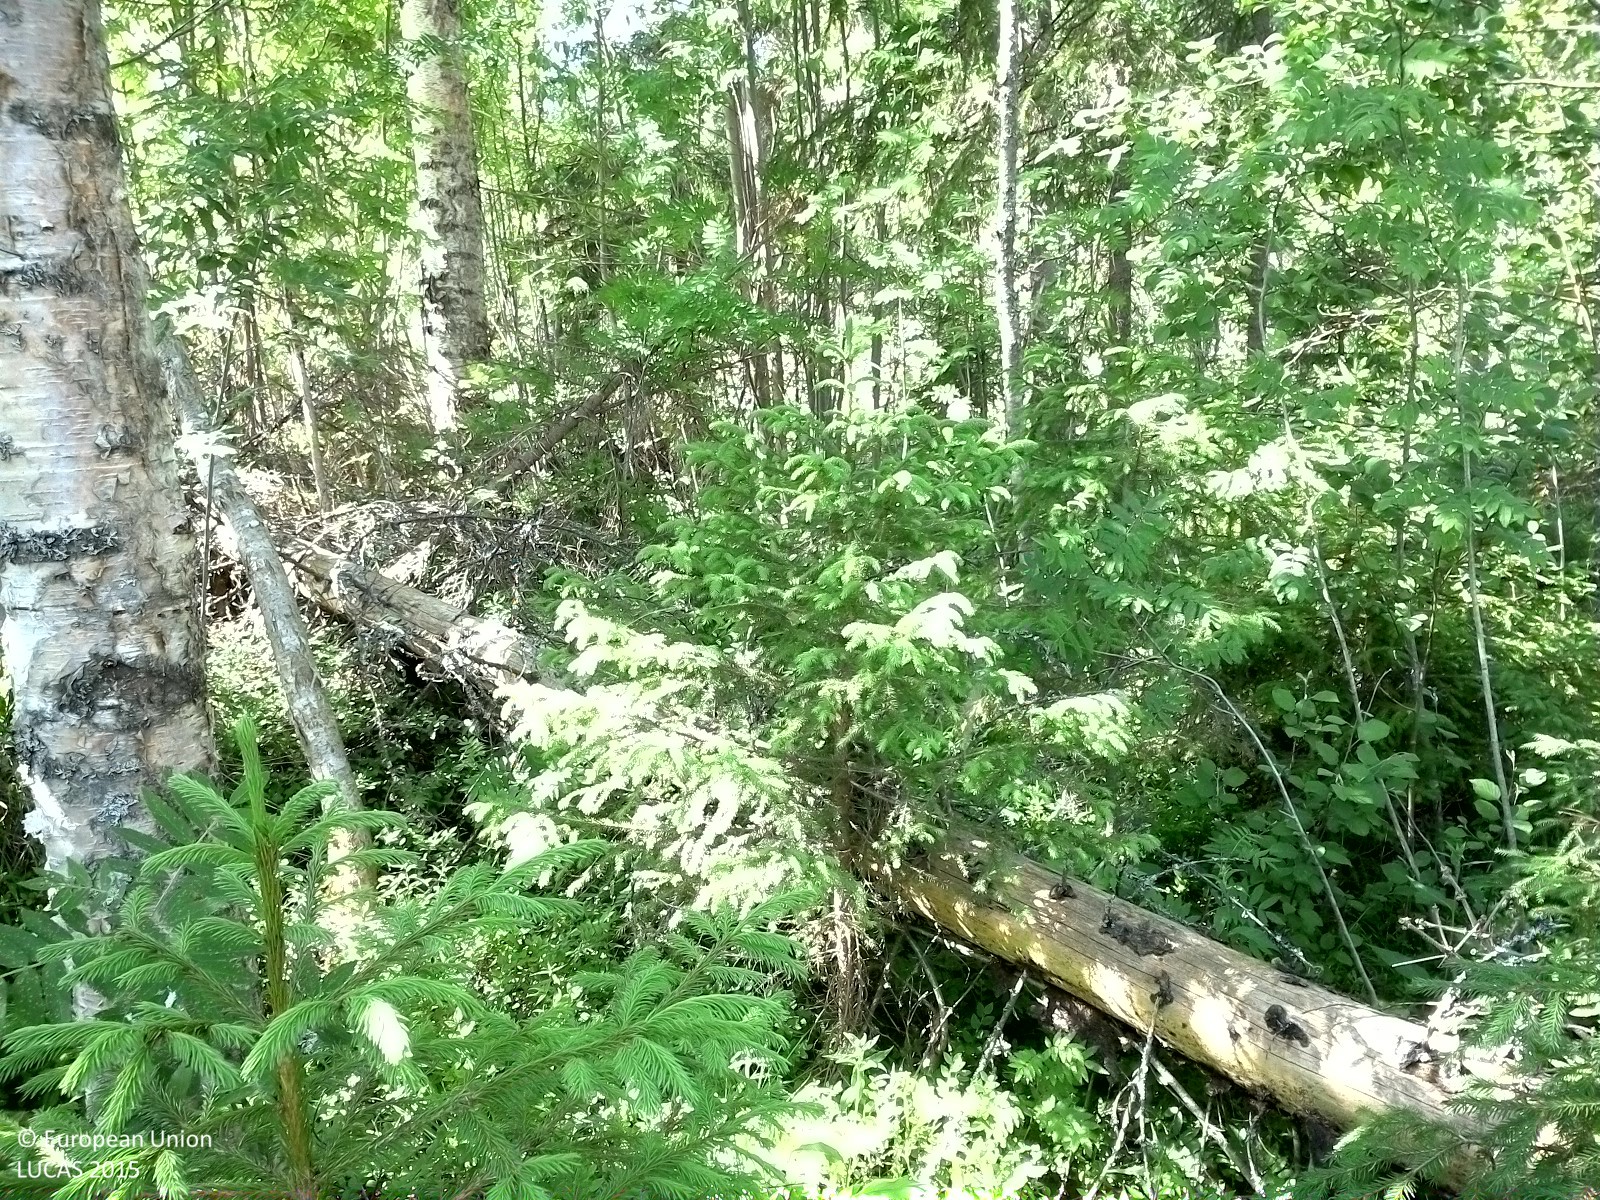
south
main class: Woodland
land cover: Spruce dominated mixed woodland
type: boreal forest
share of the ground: > 75 %
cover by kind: broadleaved forest trees 50 %, coniferous forest trees 35 %, herbaceous plants 15 %
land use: Forestry
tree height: > 5 m
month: July
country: SE
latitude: 62.2697
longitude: 16.9736
